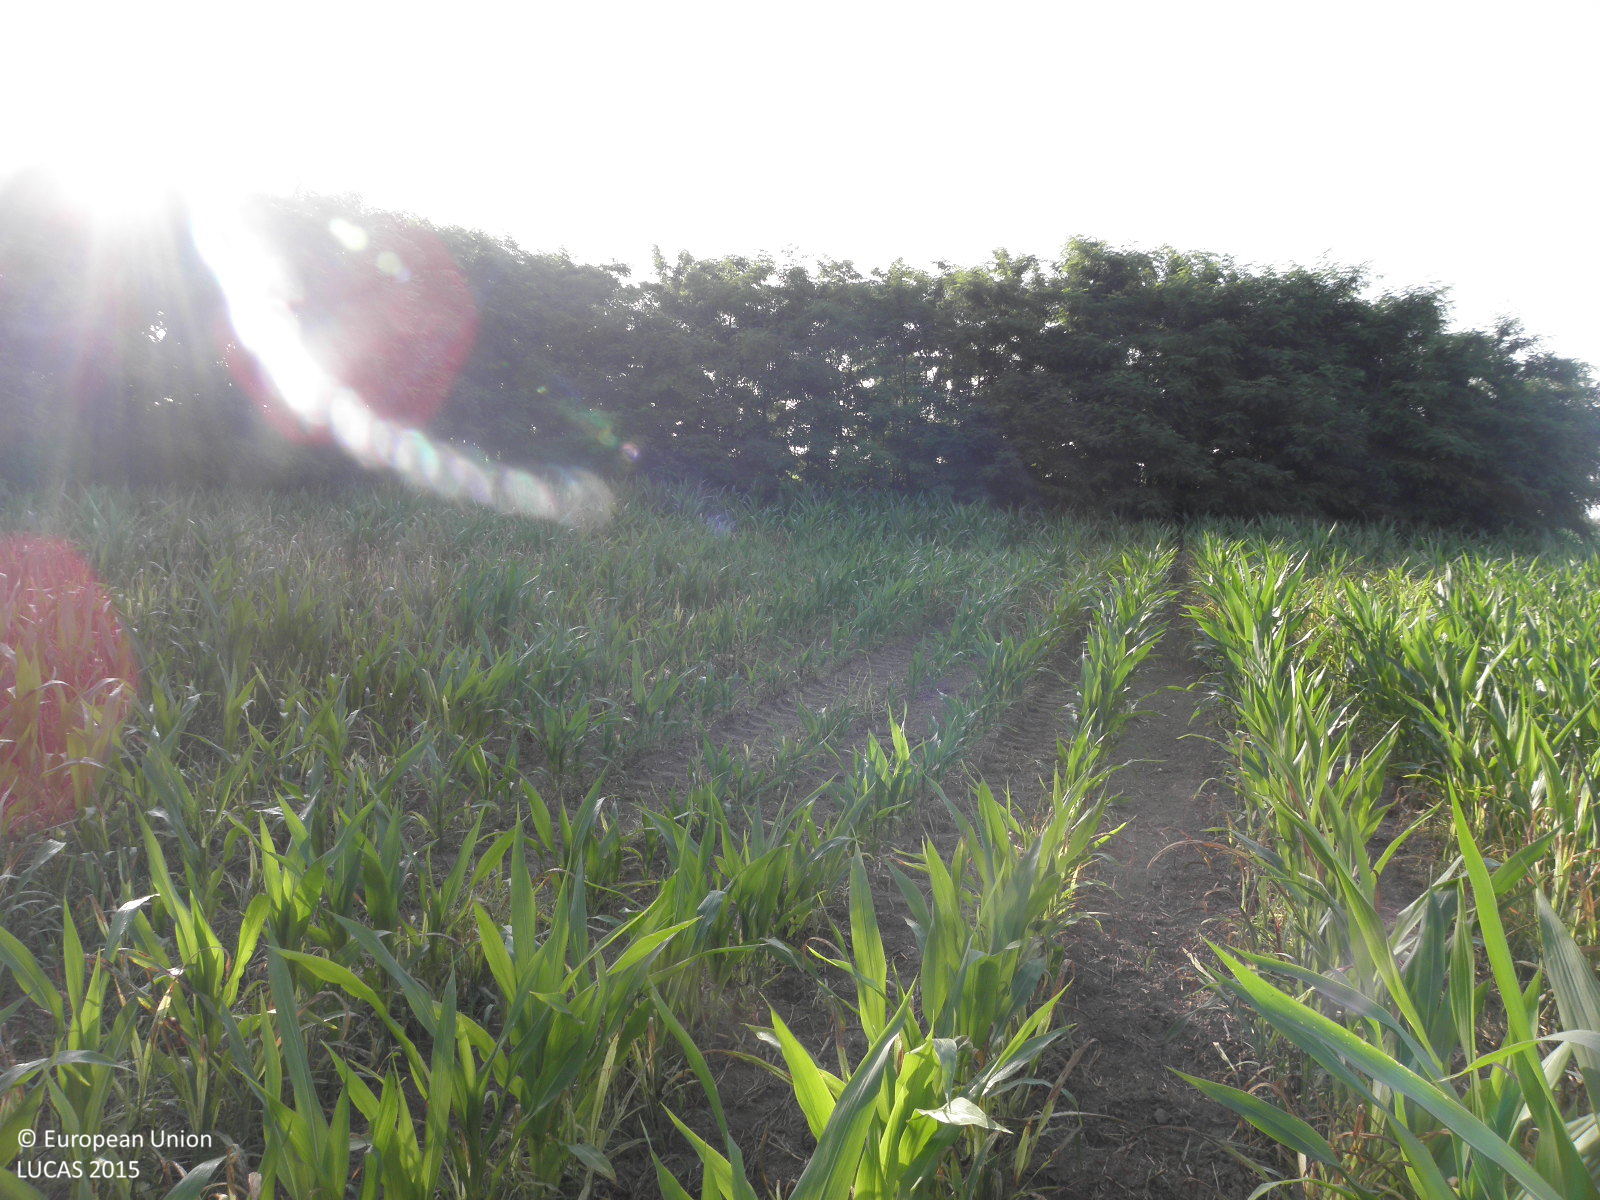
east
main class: Cropland
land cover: Maize
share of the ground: > 75 %
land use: Agriculture (excluding fallow land and kitchen gardens)
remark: Tilled/Sowed
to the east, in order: Maize; Broadleaved woodland; Tracks; Grass margins; Maize; Grass margins; Other fruit trees and berries; Clovers
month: June
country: GR
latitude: 40.2484
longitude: 22.5181
